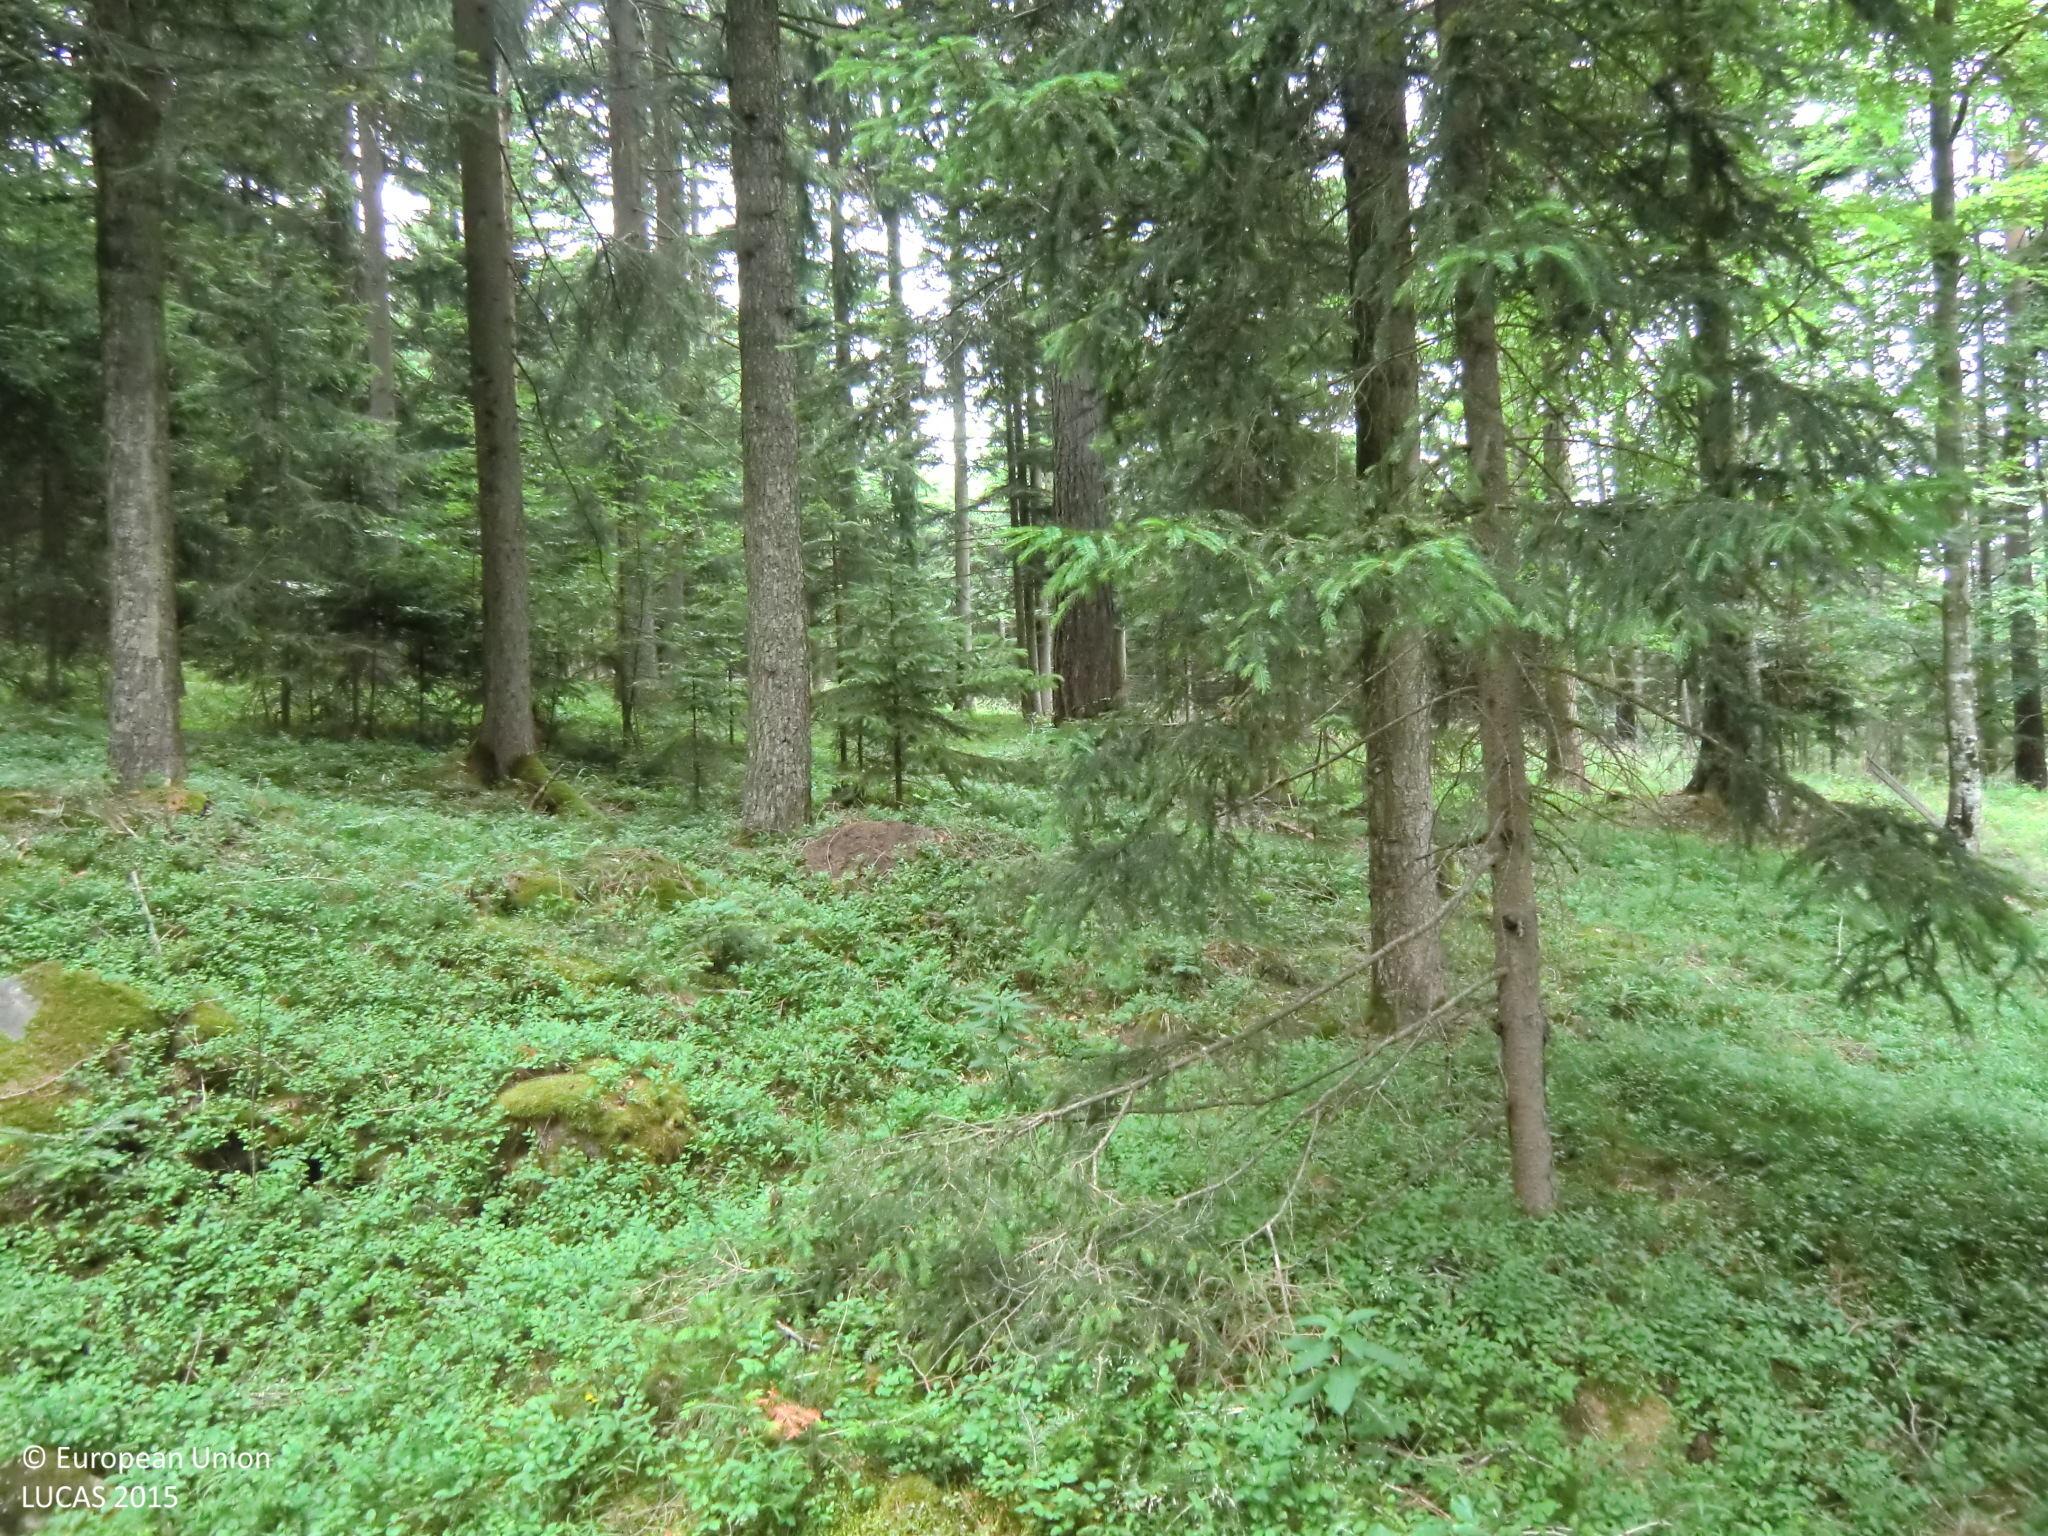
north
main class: Woodland
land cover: Spruce dominated coniferous woodland
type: alpine coniferous forest
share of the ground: > 75 %
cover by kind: coniferous forest trees 85 %, shrubs 10 %, lichens and mosses 5 %
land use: Forestry
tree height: > 5 m
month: June
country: AT
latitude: 47.2781
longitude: 15.7781
